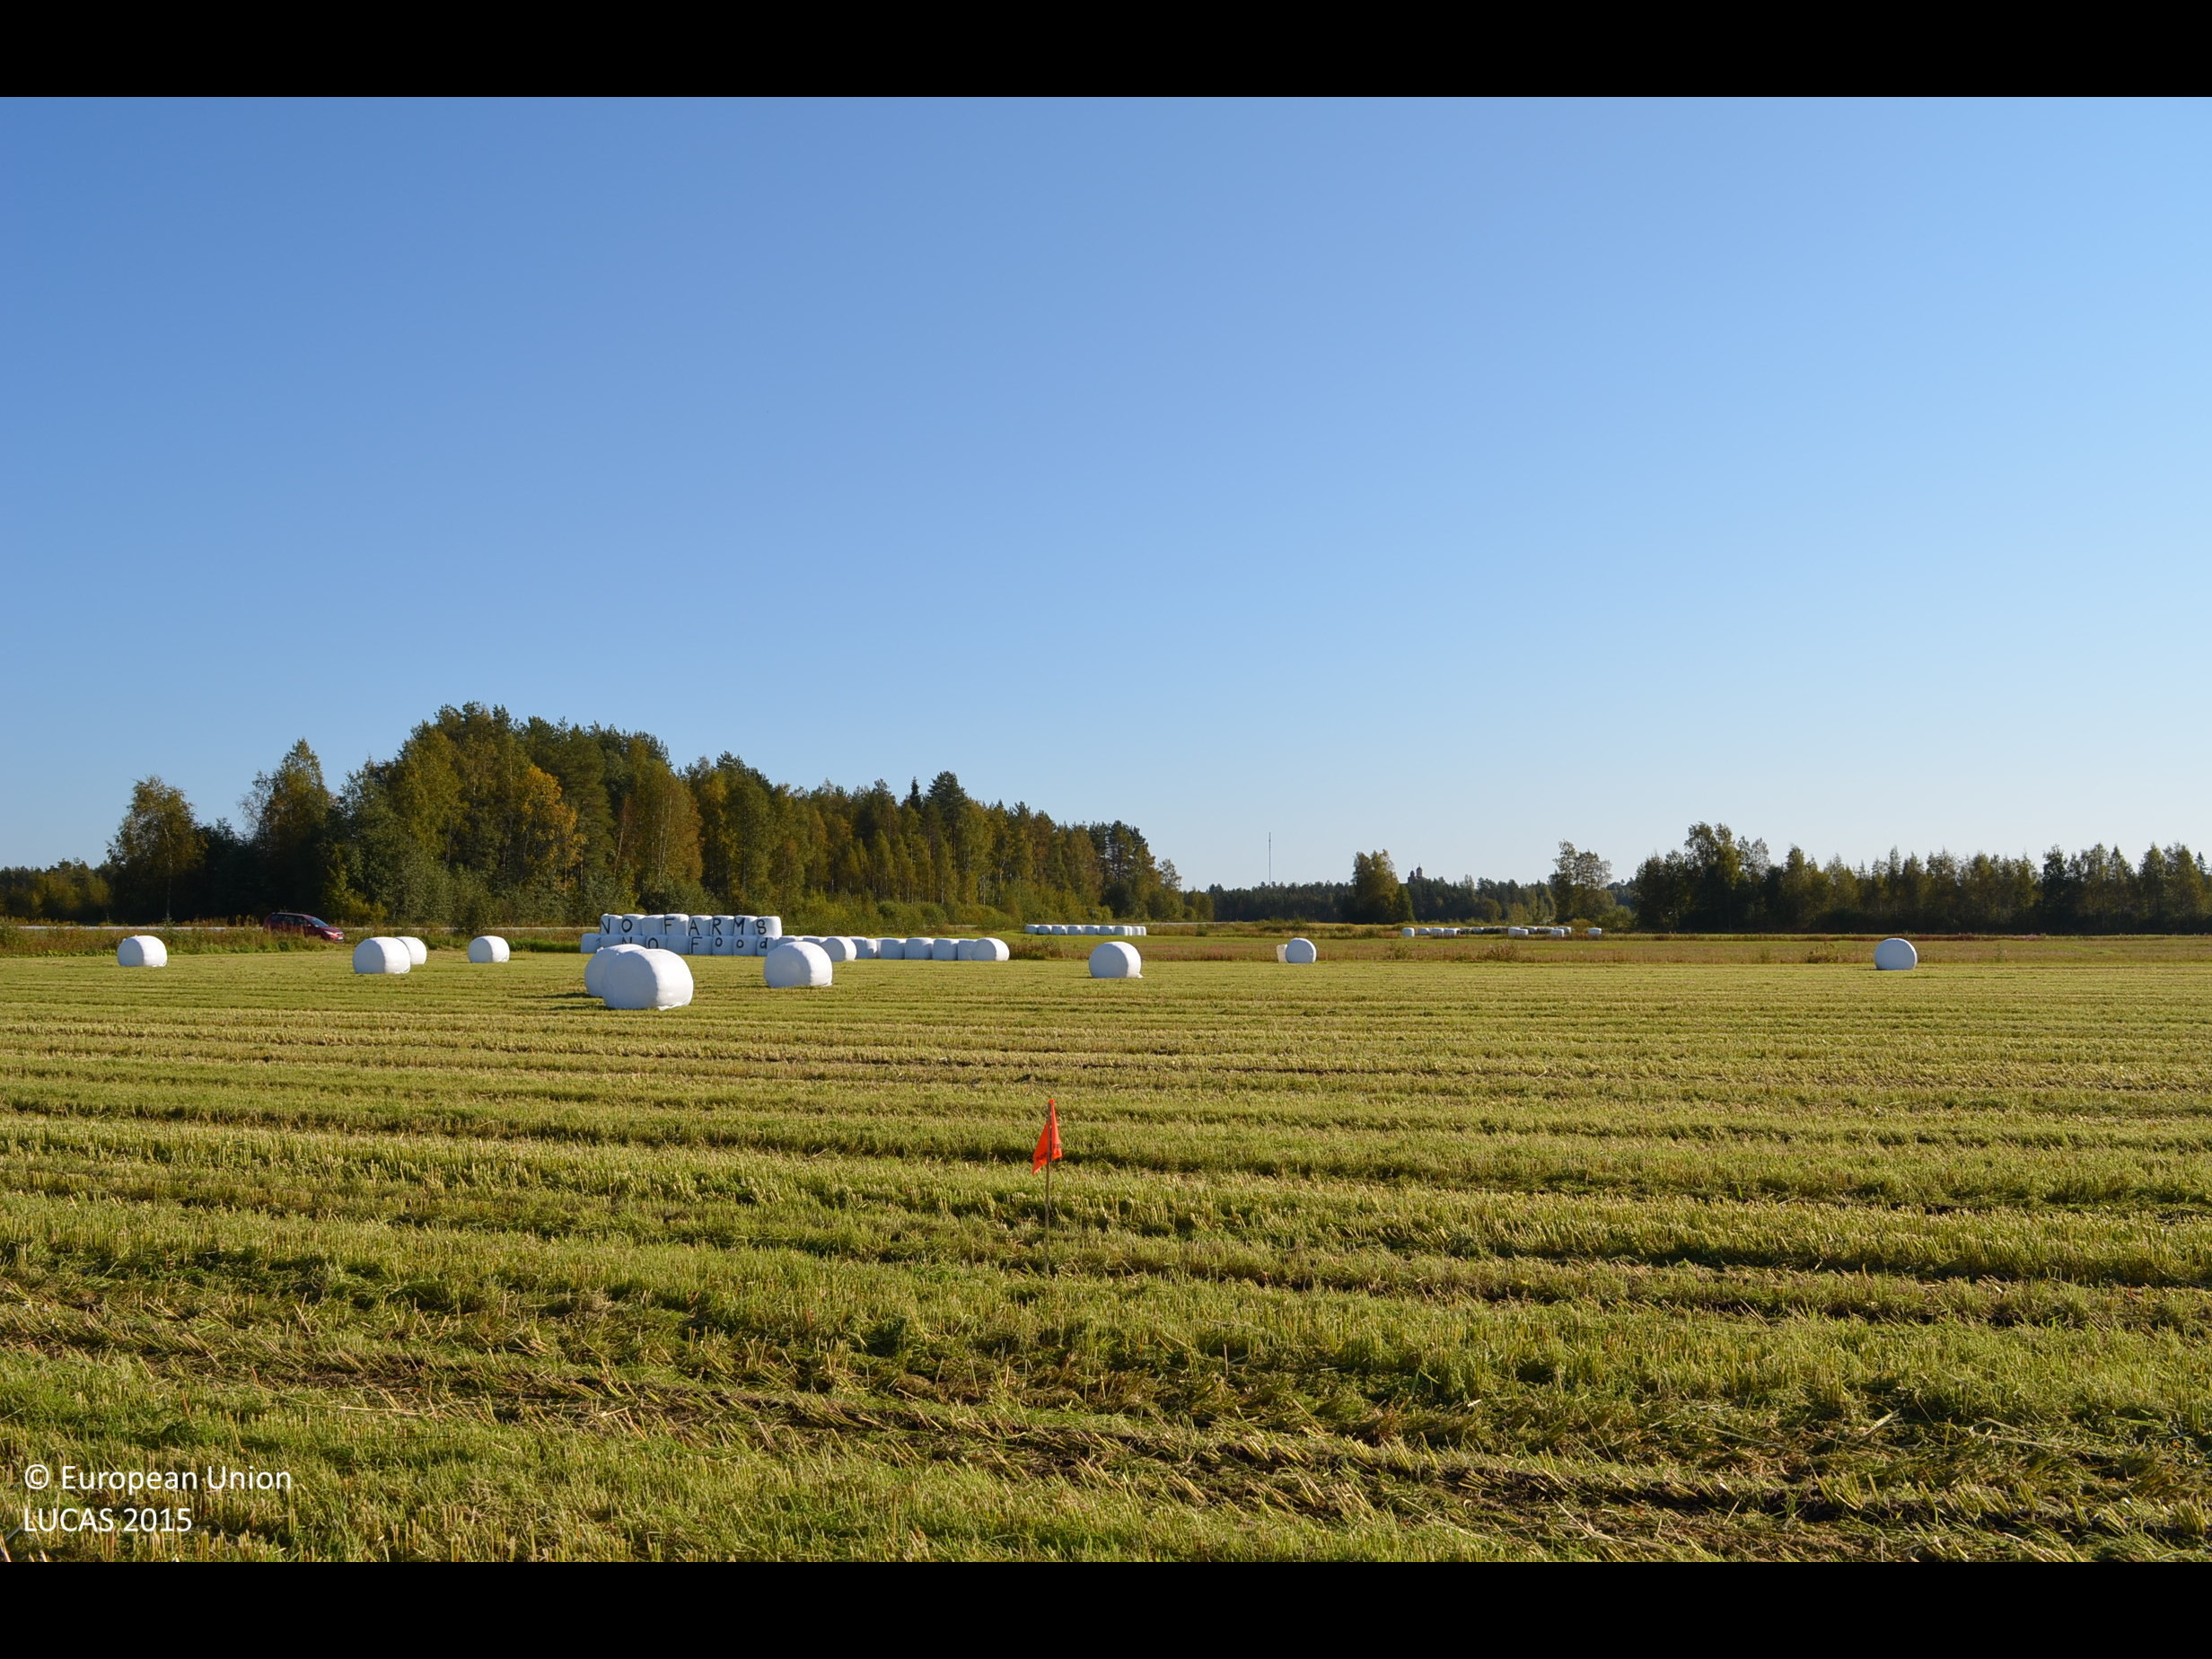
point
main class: Cropland
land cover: Temporary grasslands
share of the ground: > 75 %
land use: Agriculture (excluding fallow land and kitchen gardens)
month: September
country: FI
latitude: 62.7903
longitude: 23.8957
